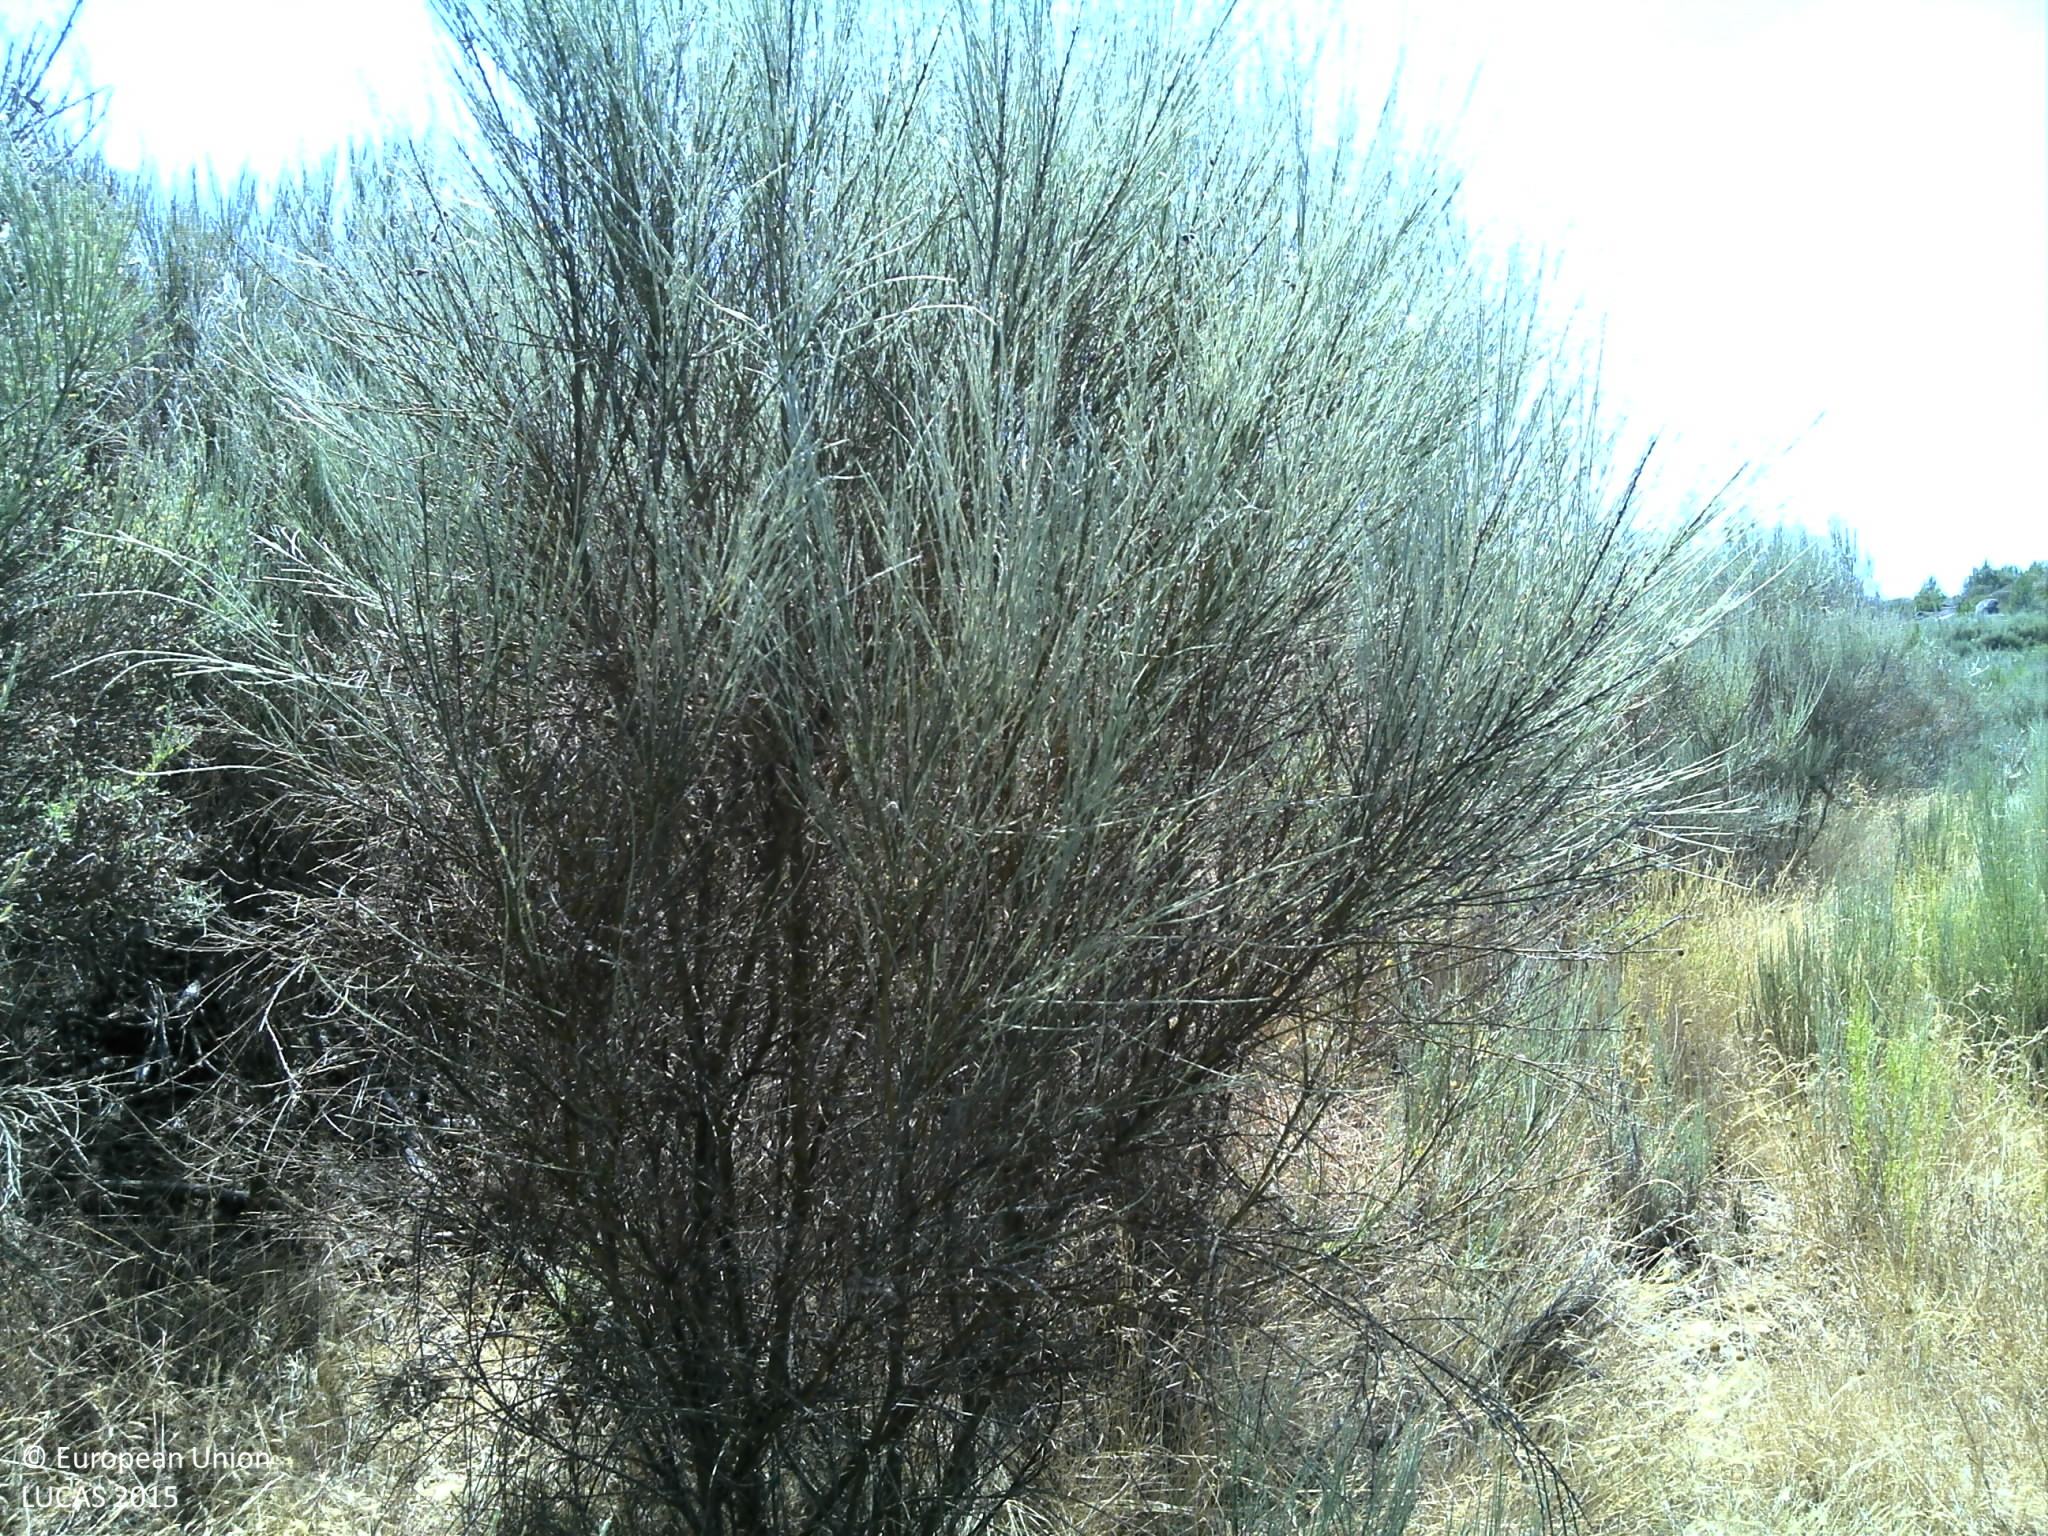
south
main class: Shrubland
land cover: Shrubland without tree cover
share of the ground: > 75 %
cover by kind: shrubs 90 %, herbaceous plants 5 %, consolidated bare surface 5 %
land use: Semi-natural and natural areas not in use
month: July
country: PT
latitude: 40.8455
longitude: -7.4683
